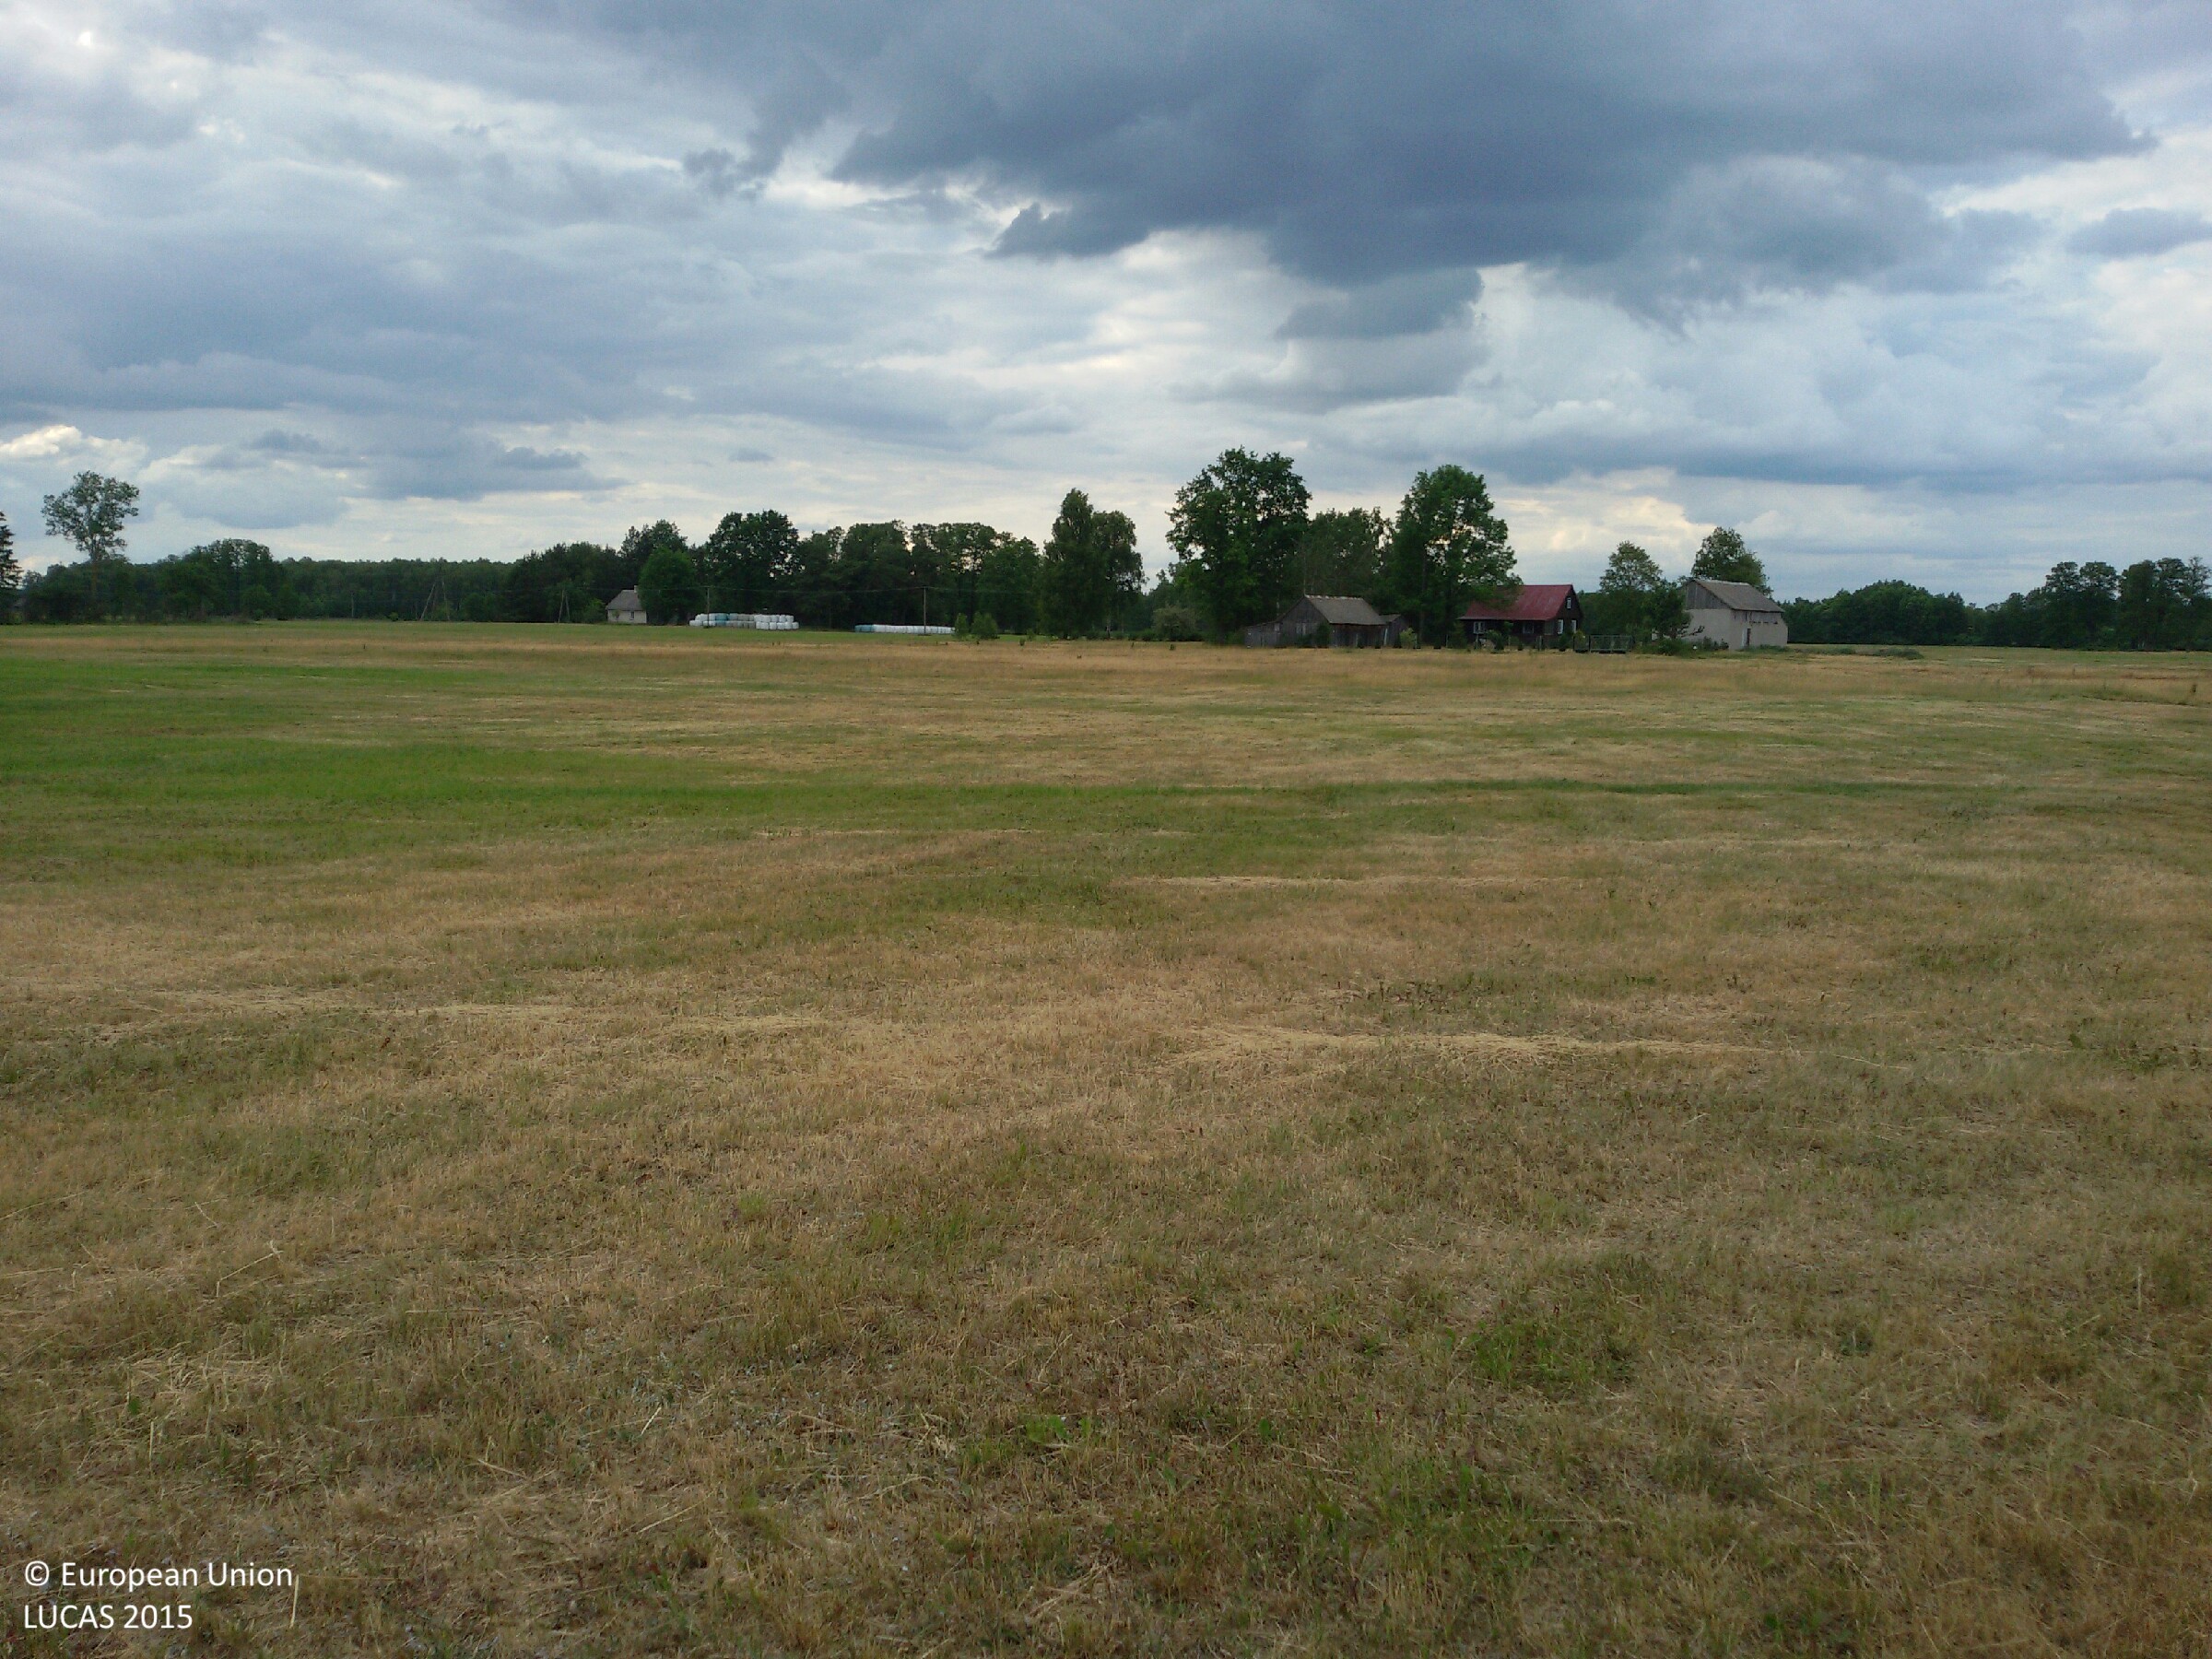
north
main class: Grassland
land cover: Grassland without tree/shrub cover
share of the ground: > 75 %
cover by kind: herbaceous plants 100 %
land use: Agriculture (excluding fallow land and kitchen gardens)
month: June
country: PL
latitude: 53.2469
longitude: 20.9682
